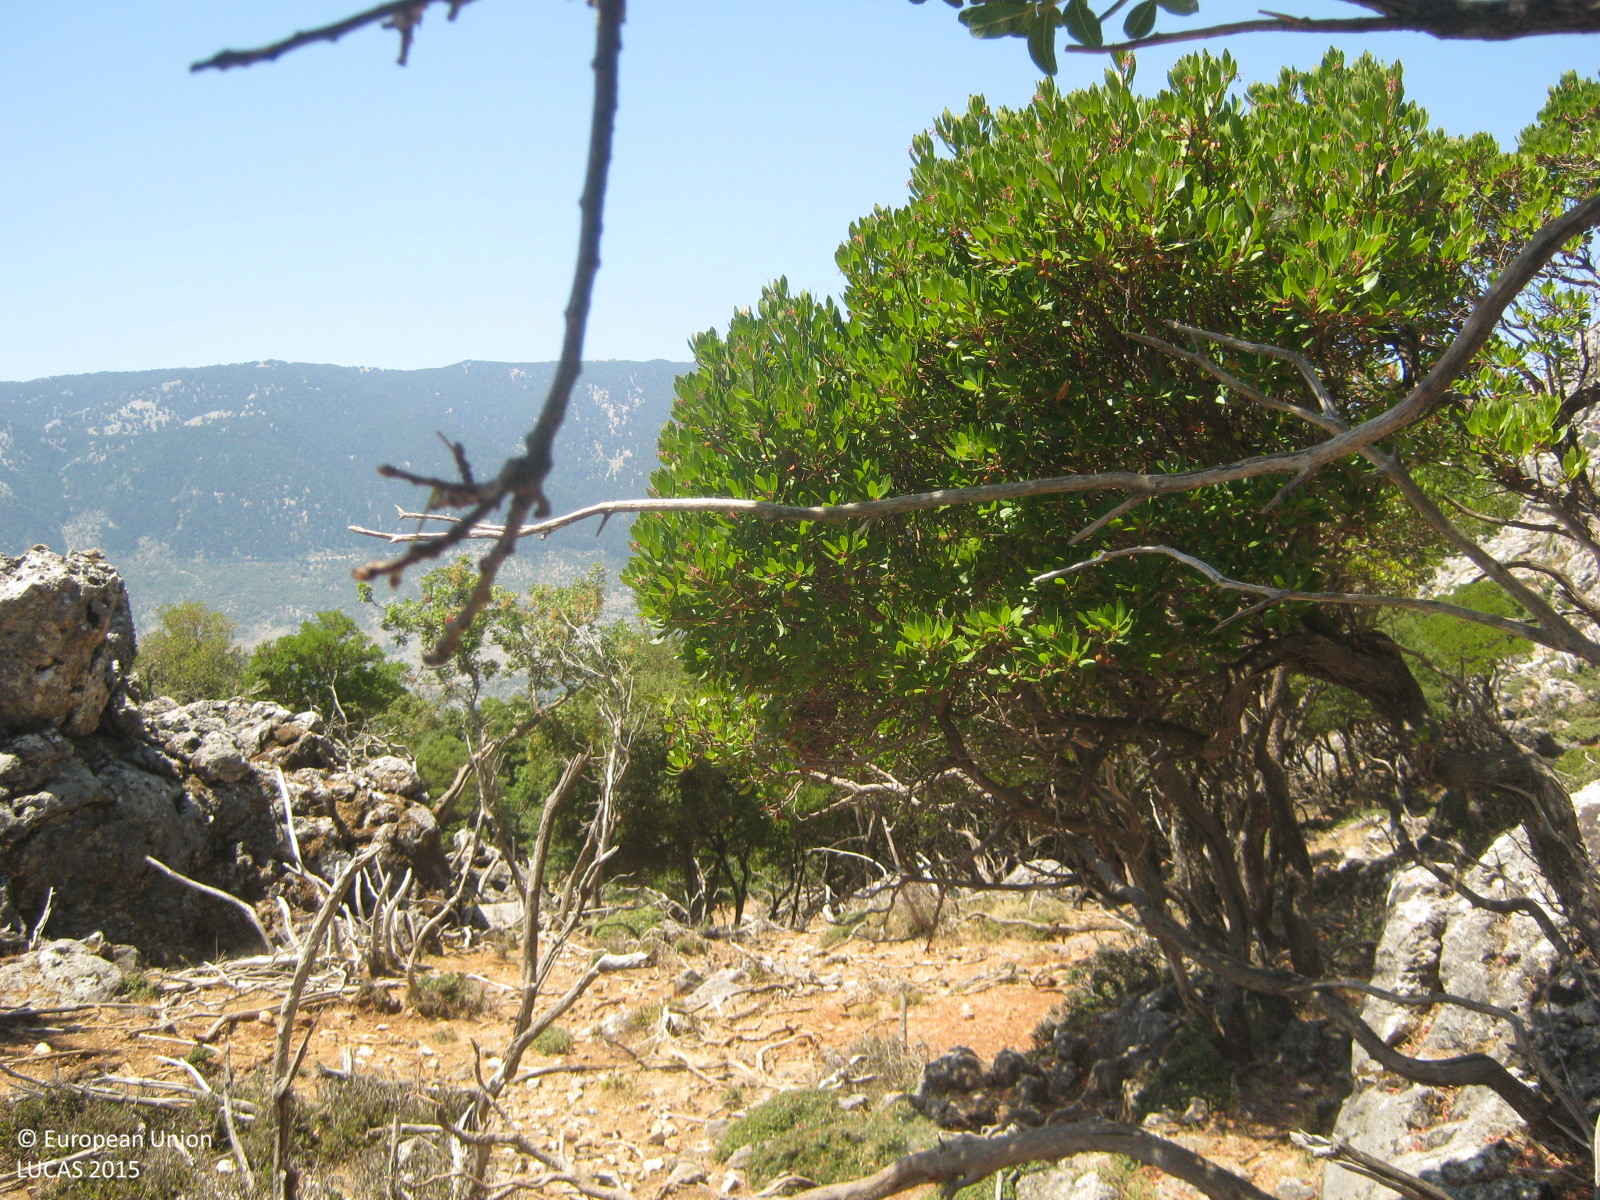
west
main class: Shrubland
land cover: Shrubland with sparse tree cover
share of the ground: 50 - 75 %
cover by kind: shrubs 70 %, unconsolidated bare surface 20 %, broadleaved forest trees 5 %, herbaceous plants 5 %
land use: Agriculture (excluding fallow land and kitchen gardens)
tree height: > 5 m
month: July
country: GR
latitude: 38.1602
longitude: 20.7466
